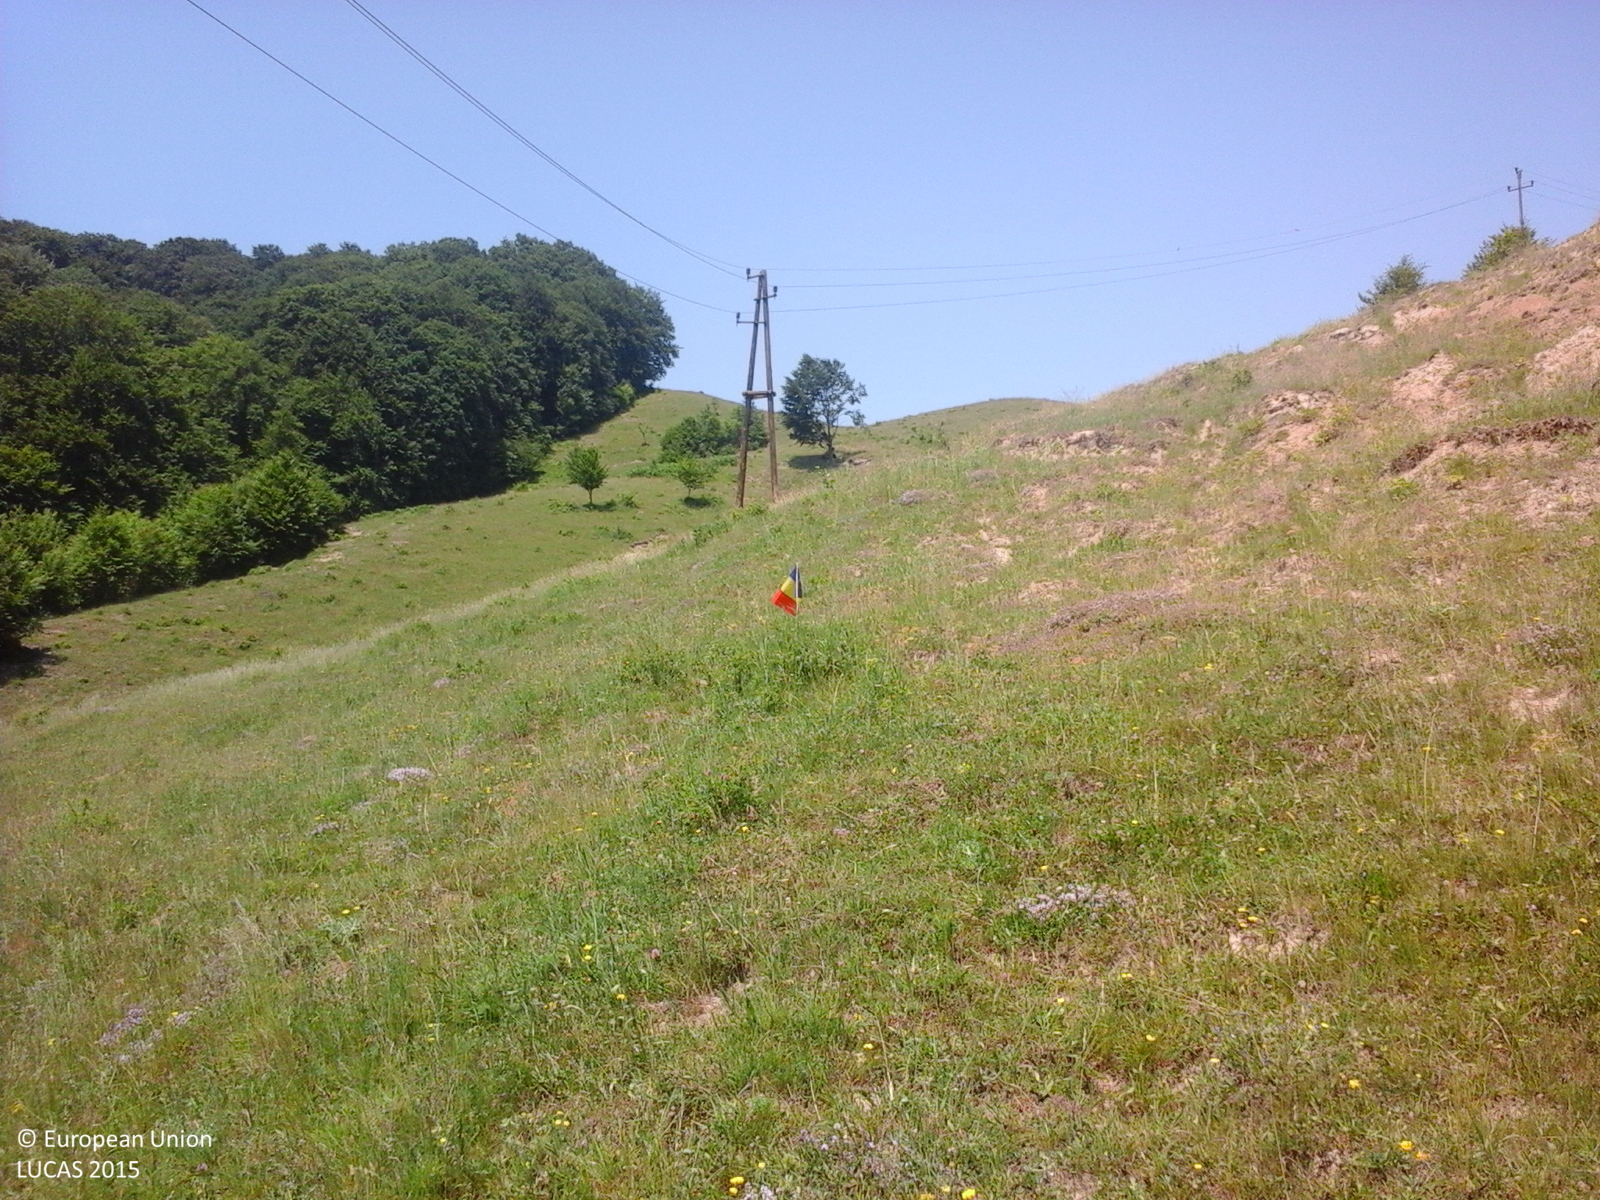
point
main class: Grassland
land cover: Grassland without tree/shrub cover
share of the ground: > 75 %
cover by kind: herbaceous plants 100 %
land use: Agriculture (excluding fallow land and kitchen gardens)
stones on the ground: < 10 %
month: June
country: RO
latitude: 46.6726
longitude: 26.5147
